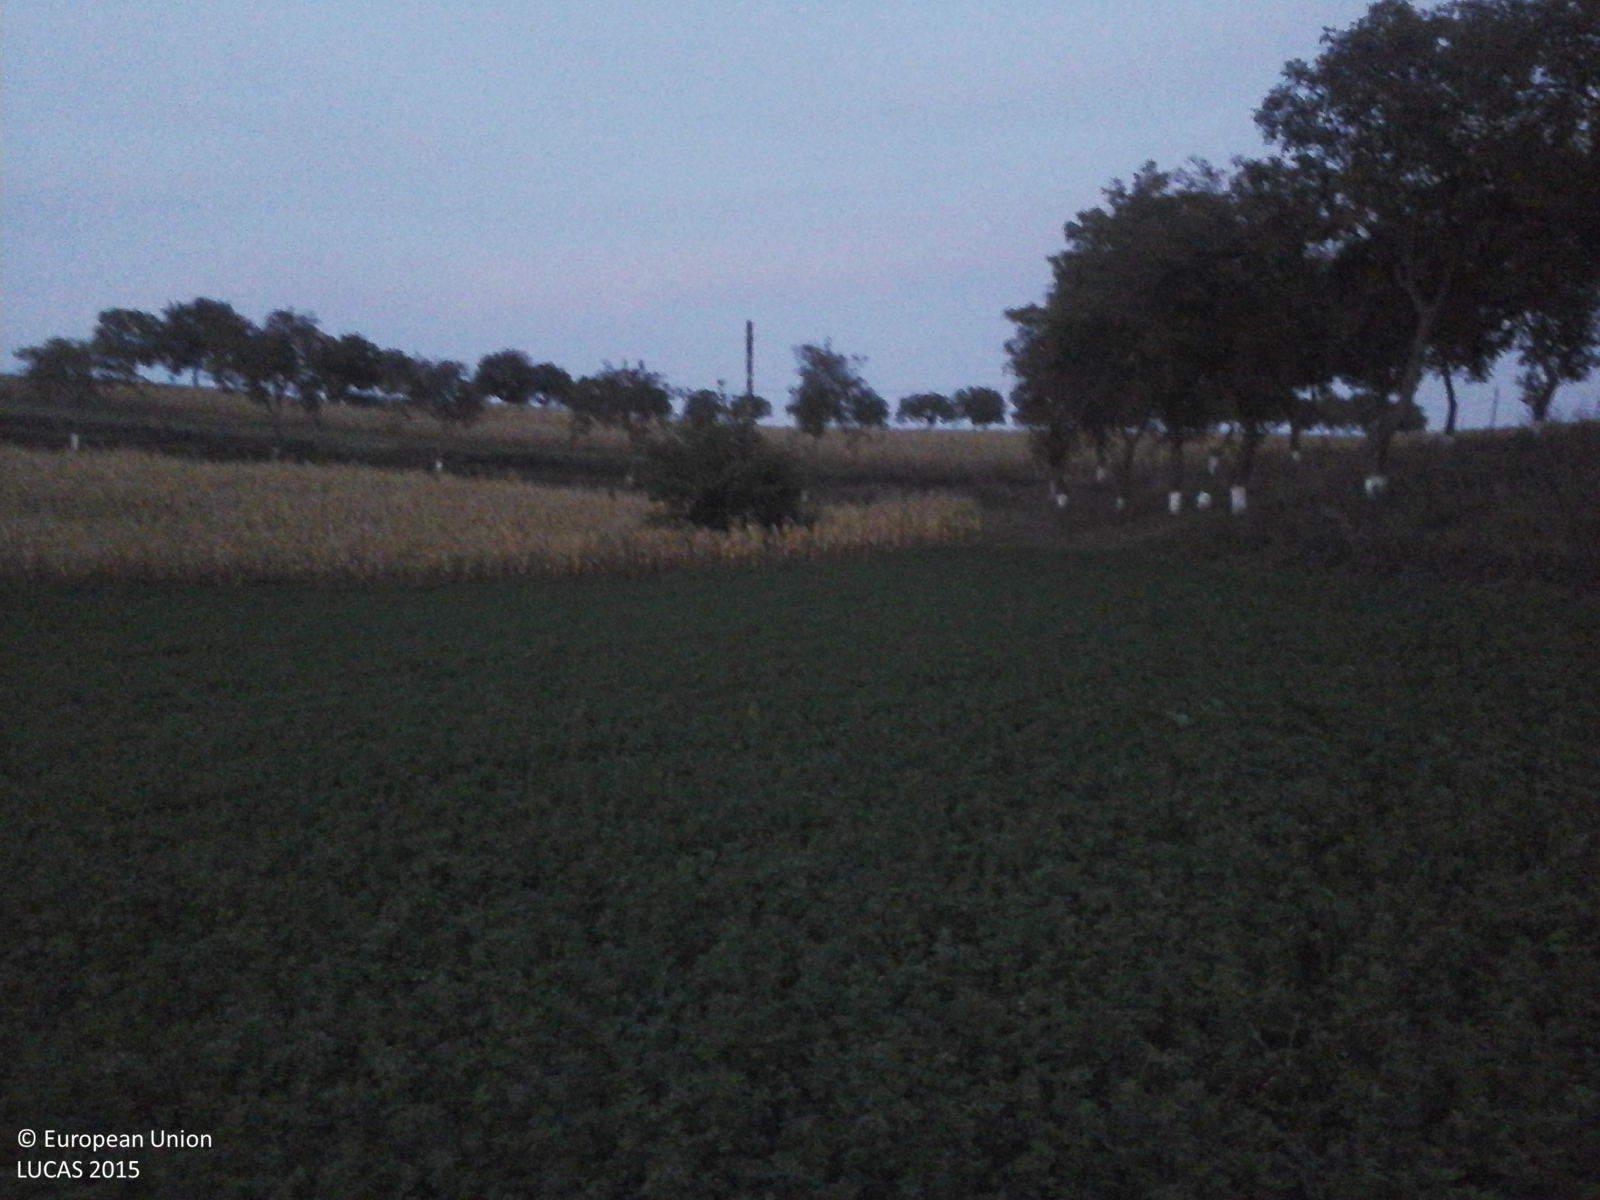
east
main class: Cropland
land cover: Lucerne
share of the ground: > 75 %
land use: Agriculture (excluding fallow land and kitchen gardens)
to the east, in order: Lucerne; Maize; Electric lines; Lines of trees; Grass margins; Paved roads, cycling and walking lanes; Grass margins; Lucerne; Maize; Potatoes; Maize; Potatoes; Maize; Lucerne; Maize; Lucerne
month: September
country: RO
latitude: 46.5969
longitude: 23.9790
